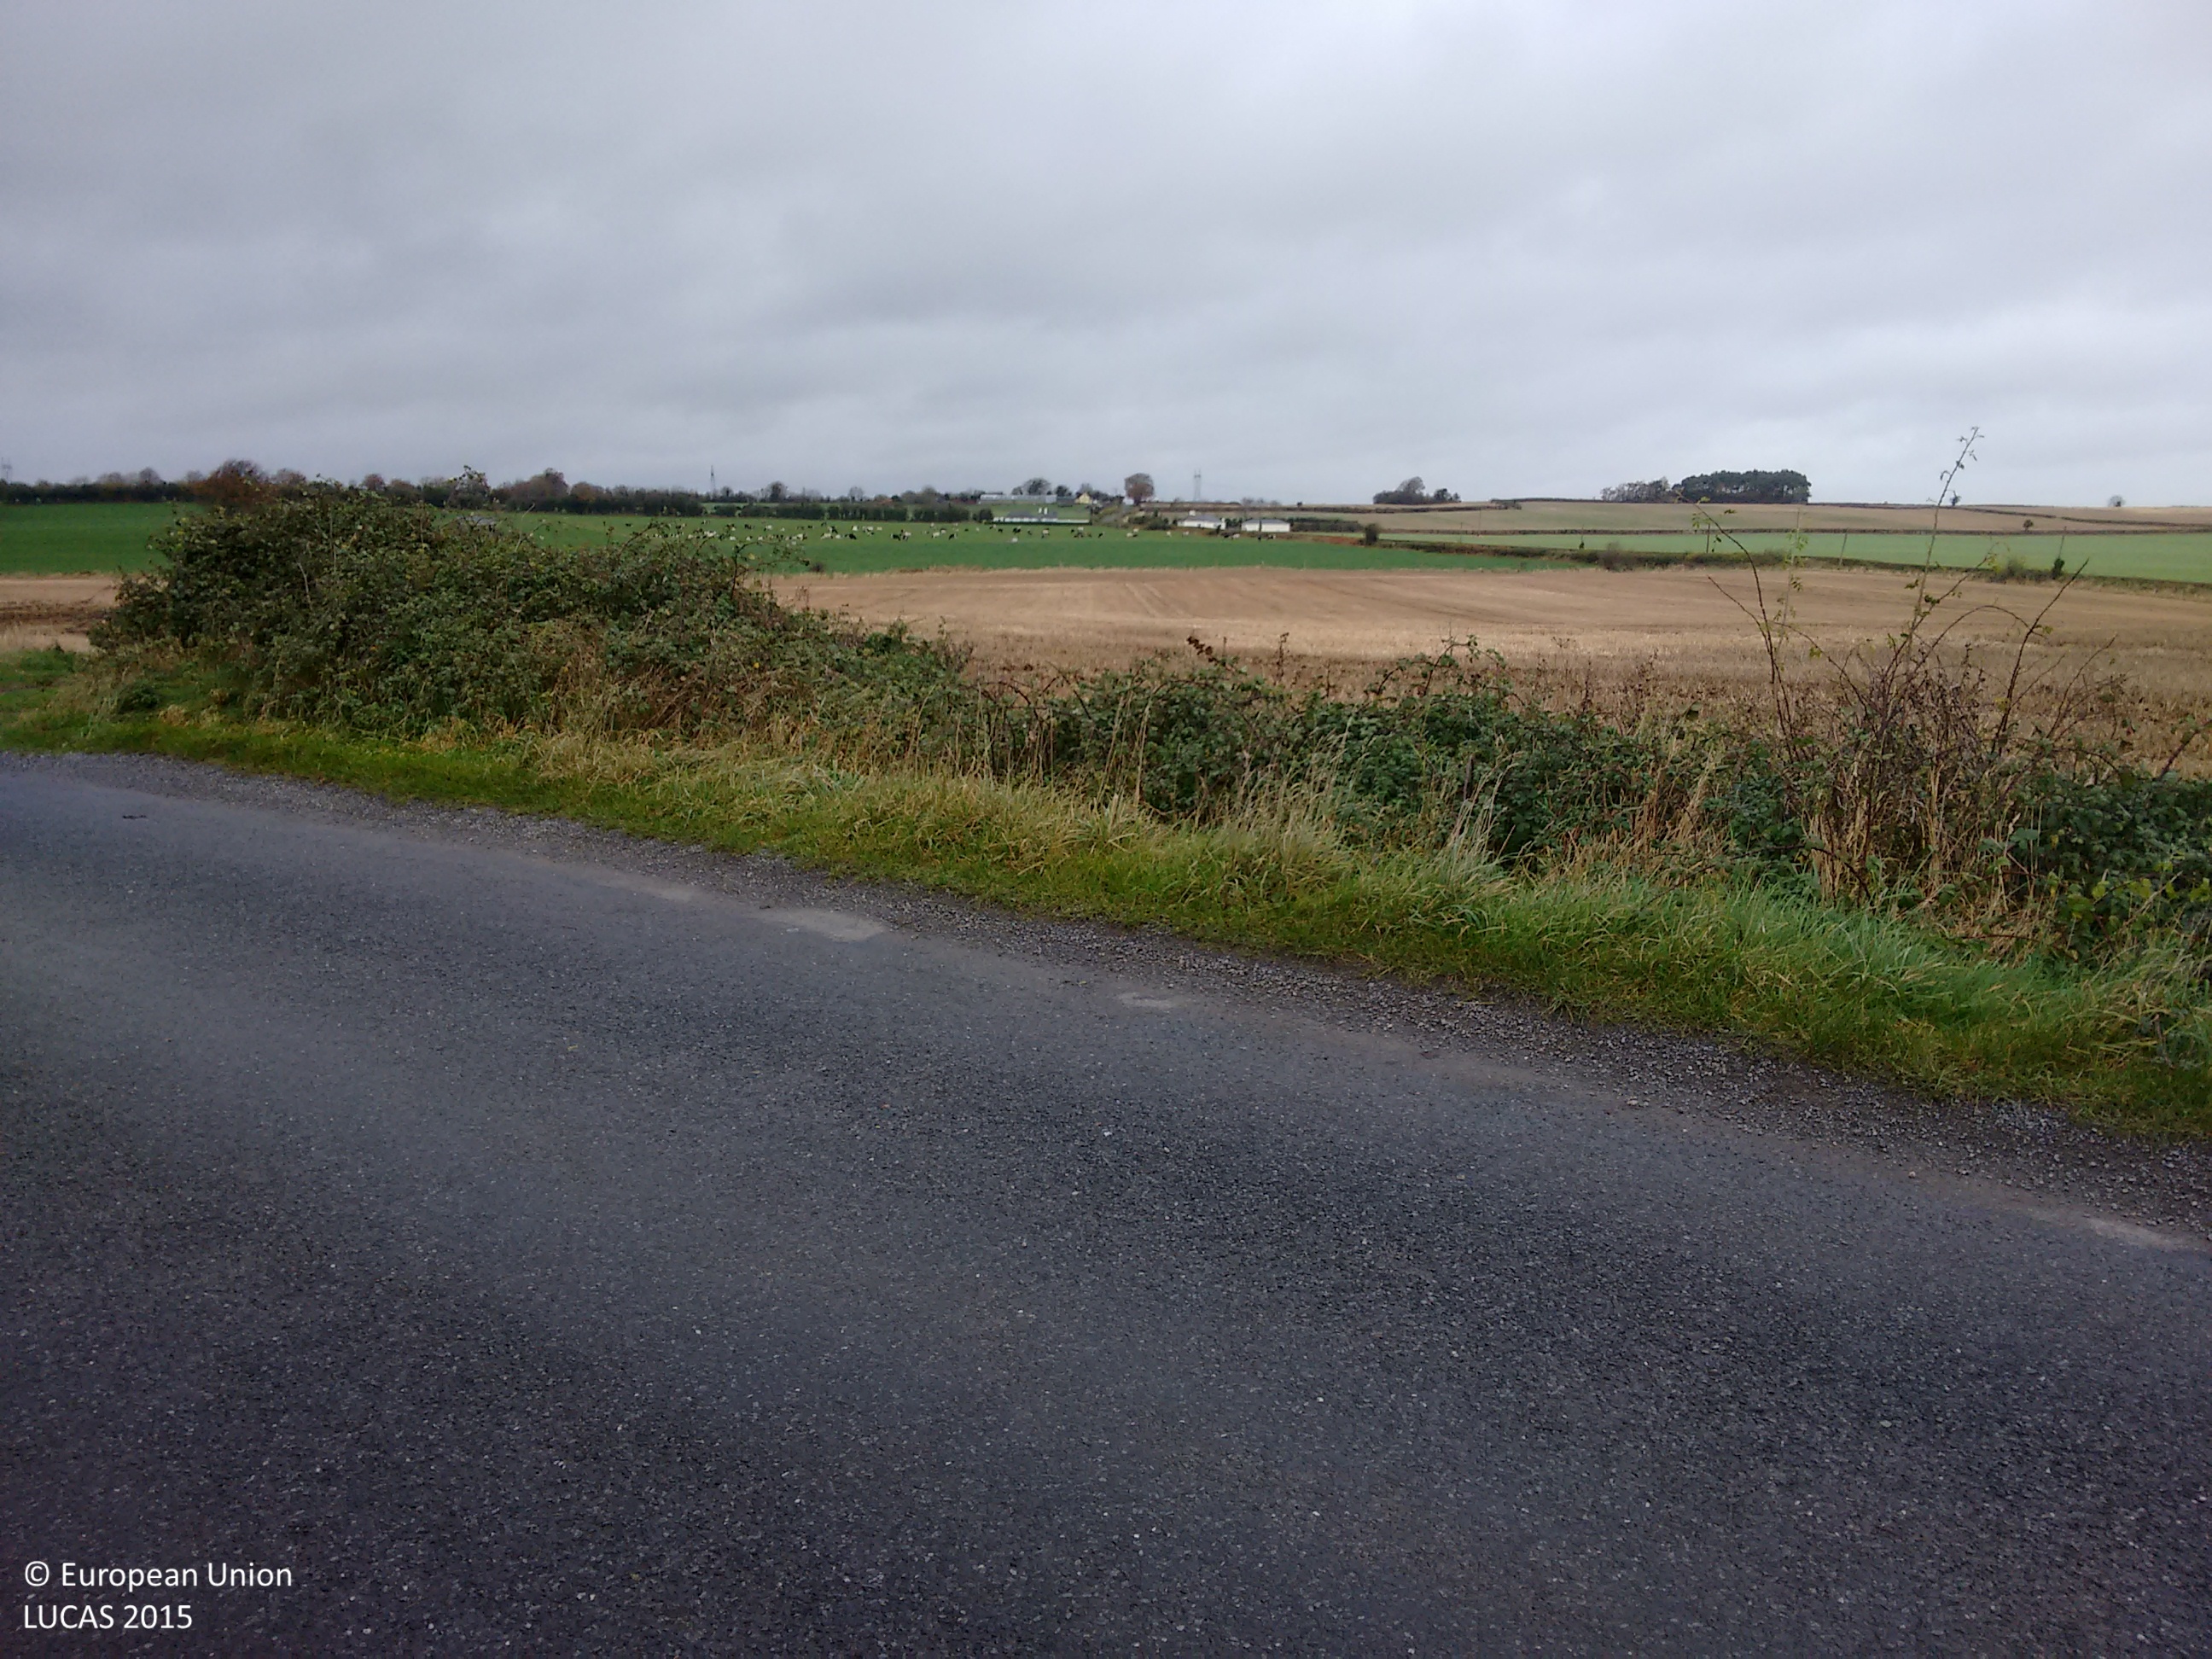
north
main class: Cropland
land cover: Common wheat
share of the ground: > 75 %
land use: Agriculture (excluding fallow land and kitchen gardens)
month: November
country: IE
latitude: 53.1857
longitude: -7.5958
